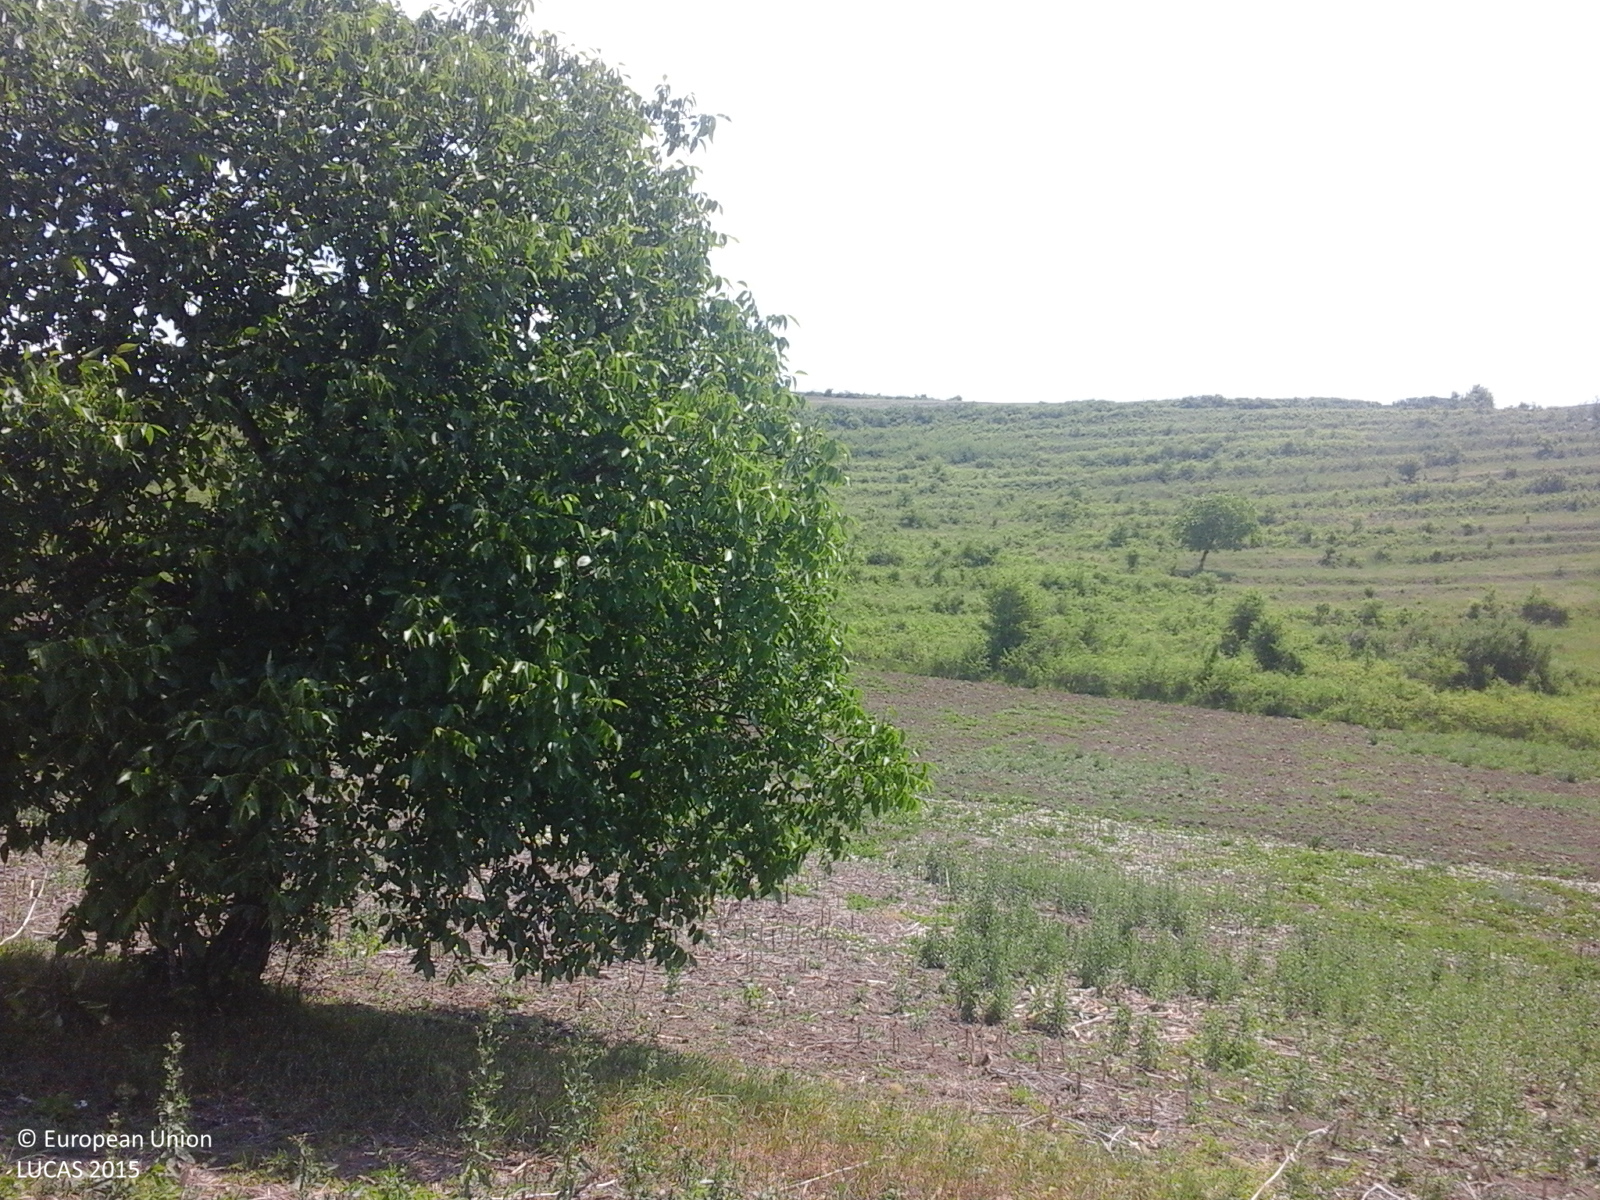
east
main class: Grassland
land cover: Spontaneously vegetated surfaces
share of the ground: > 75 %
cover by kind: herbaceous plants 100 %
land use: Agriculture (excluding fallow land and kitchen gardens)
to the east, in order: Spontaneously vegetated surfaces; Single bushes/trees; Other bare soil; Shrubland with sparse tree cover; Lucerne
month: June
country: RO
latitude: 46.3923
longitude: 27.1217
